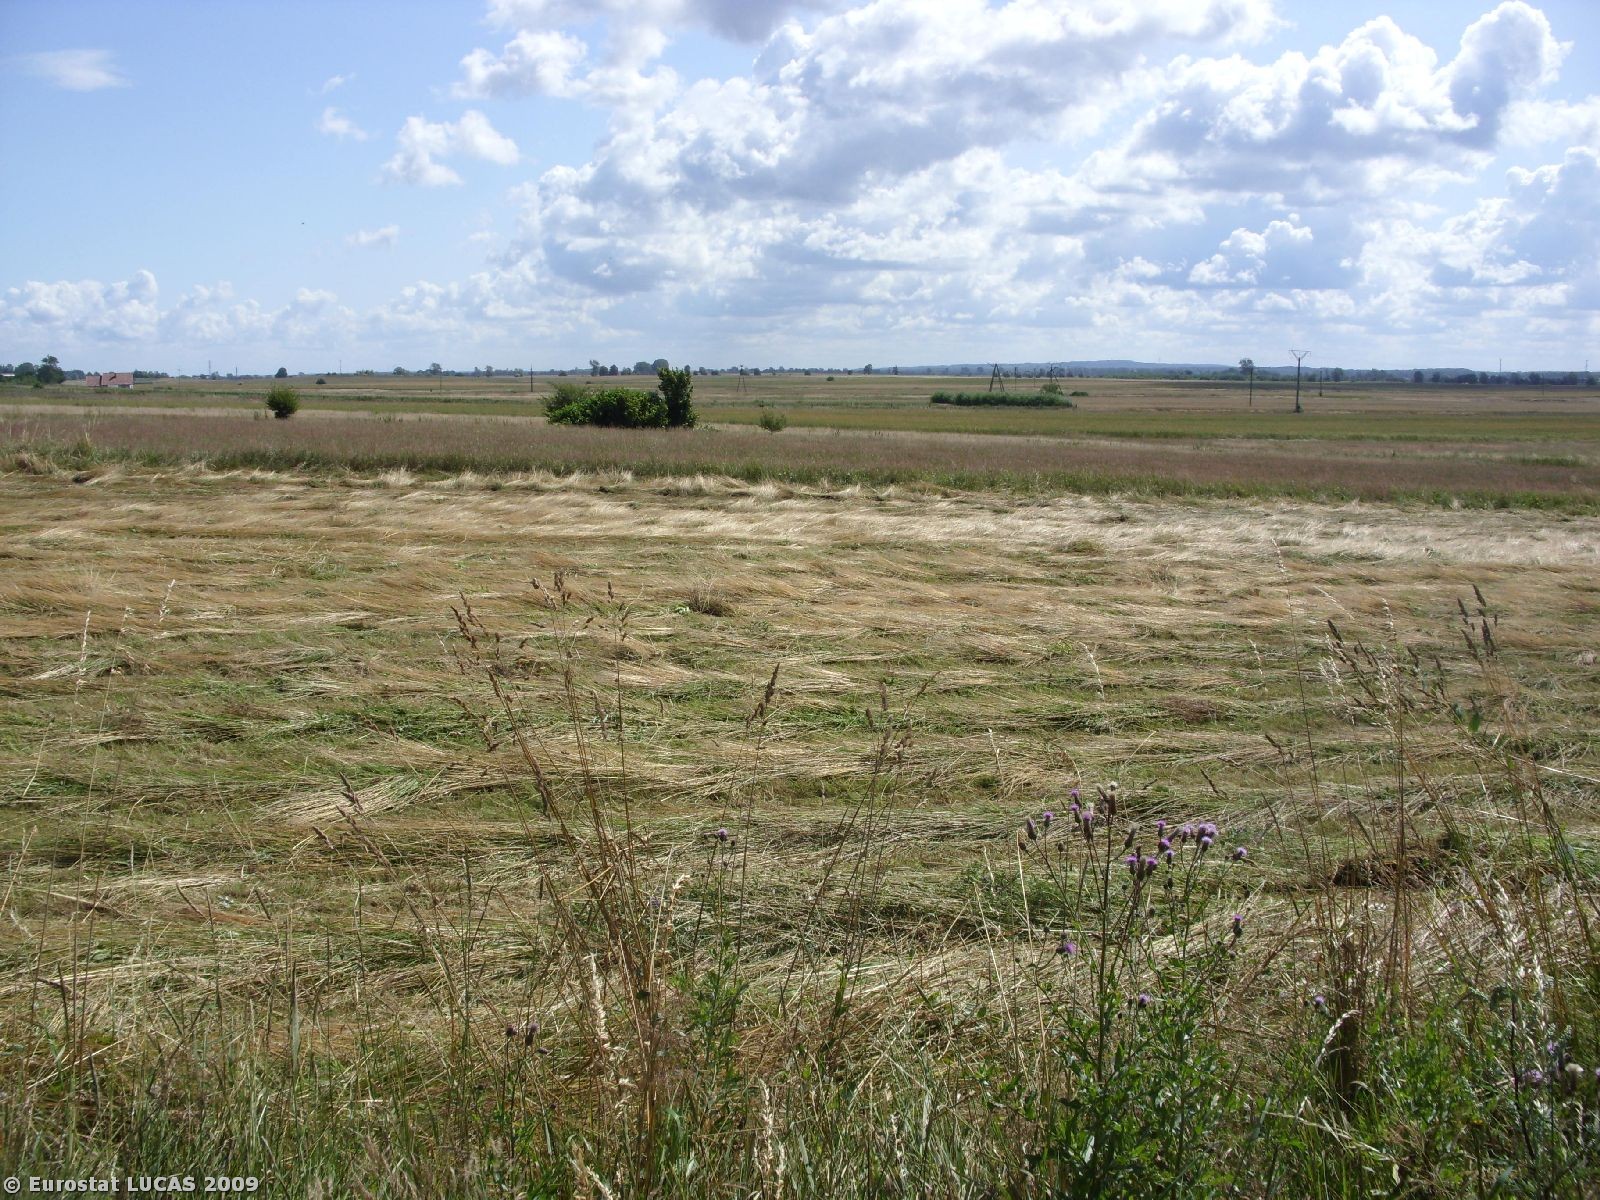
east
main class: Cropland
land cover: Other cereals
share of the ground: > 75 %
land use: Agriculture (excluding fallow land and kitchen gardens)
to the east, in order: Other cereals; Grassland without tree/shrub cover; Tracks; Grassland without tree/shrub cover; Oats
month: July
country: PL
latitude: 54.2444
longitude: 16.0044
